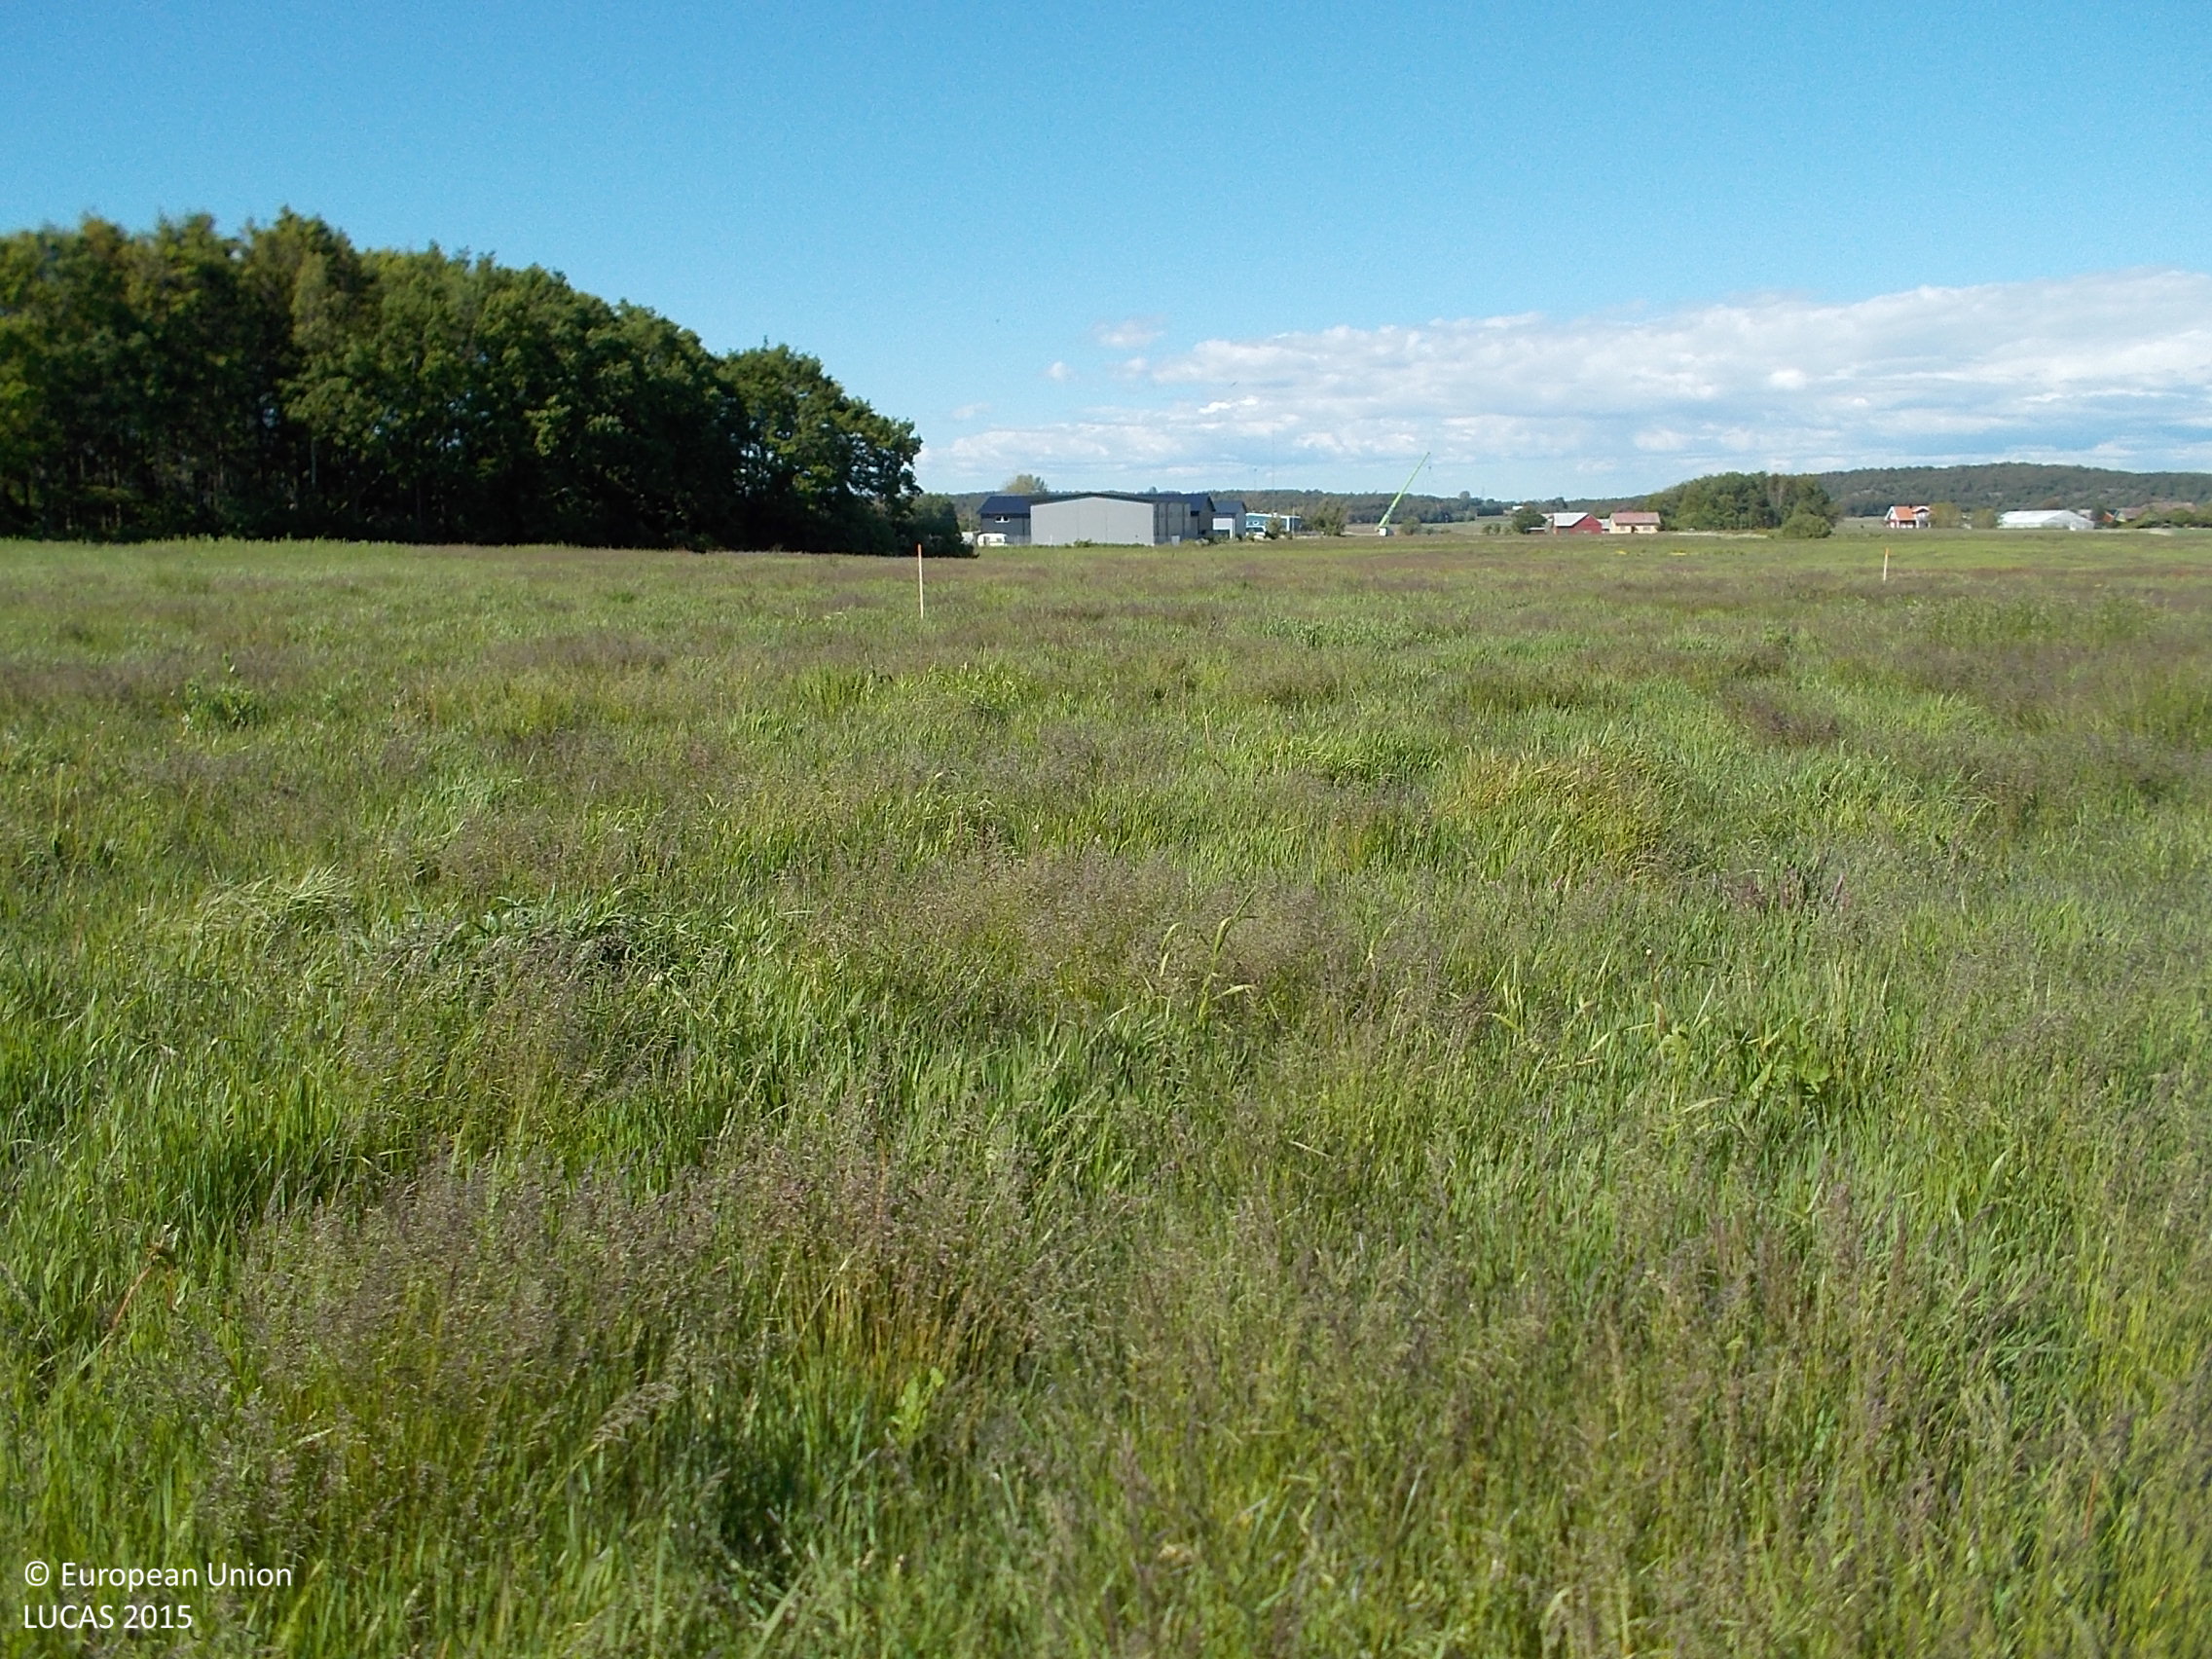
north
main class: Grassland
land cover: Grassland without tree/shrub cover
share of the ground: > 75 %
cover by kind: herbaceous plants 100 %
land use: Agriculture (excluding fallow land and kitchen gardens)
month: June
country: SE
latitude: 57.2311
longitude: 12.1339
